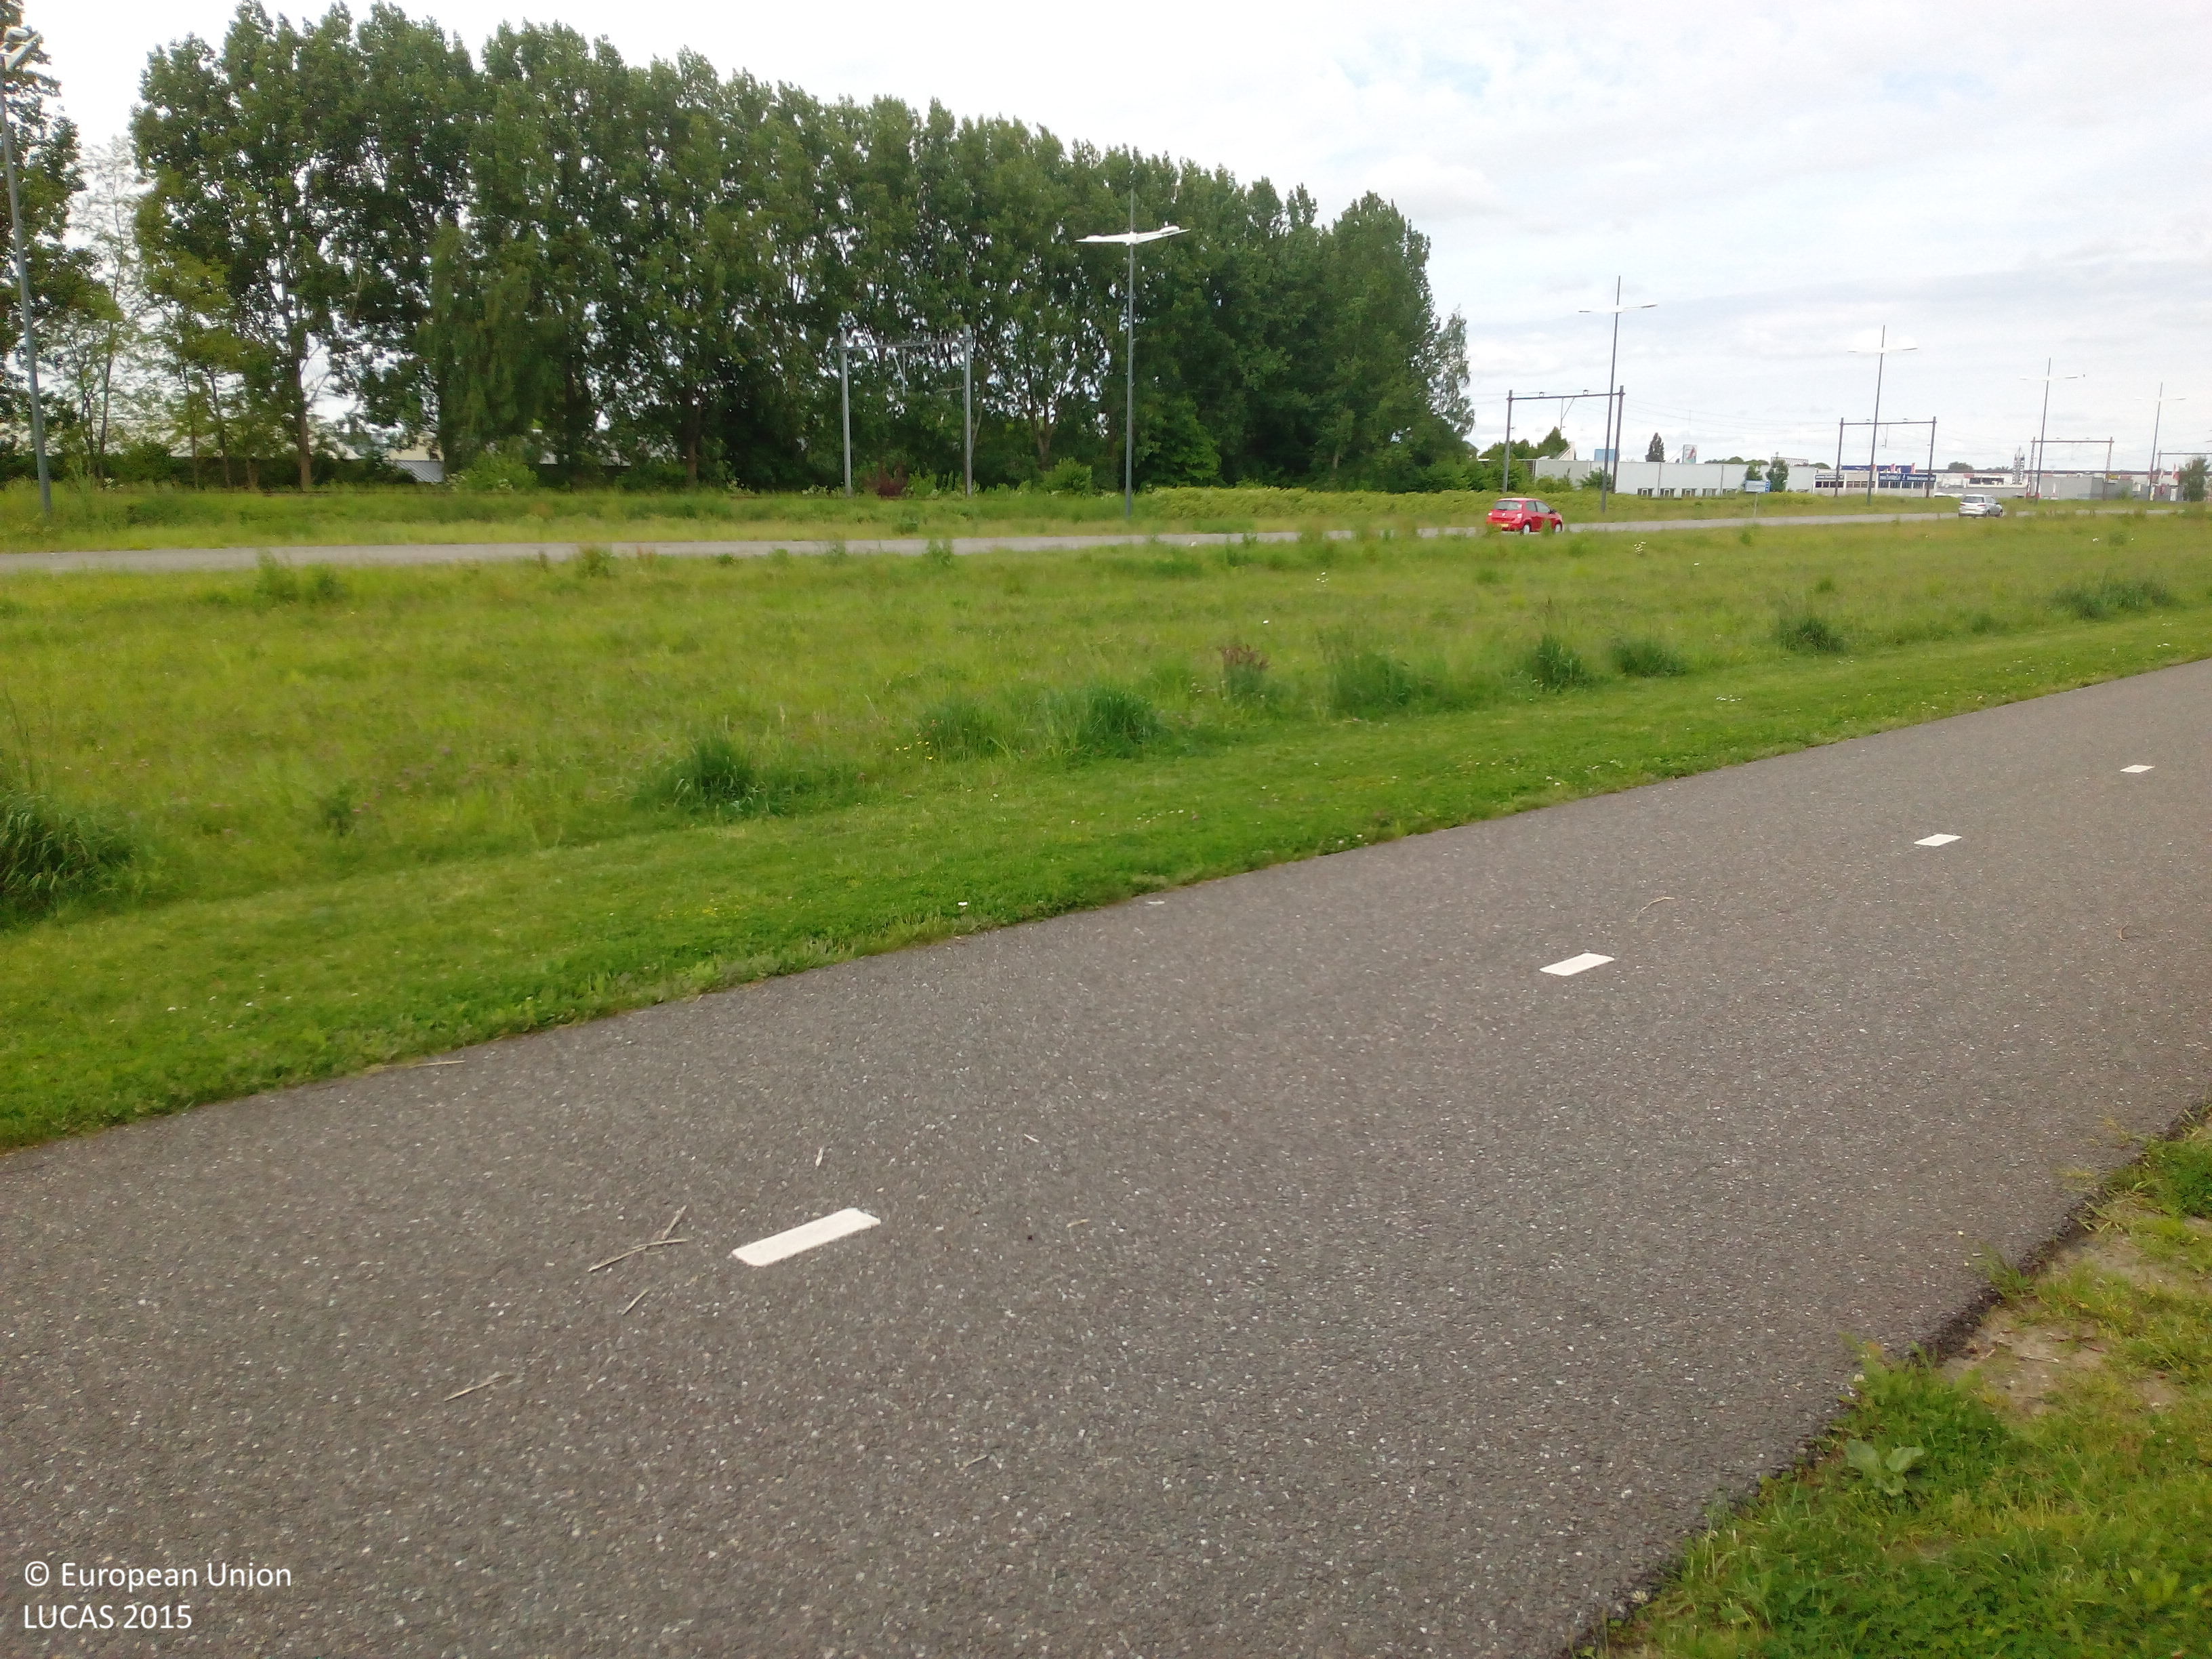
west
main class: Grassland
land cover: Grassland without tree/shrub cover
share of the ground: > 75 %
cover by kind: herbaceous plants 100 %
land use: Road transport
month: May
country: NL
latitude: 52.2449
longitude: 6.2061
